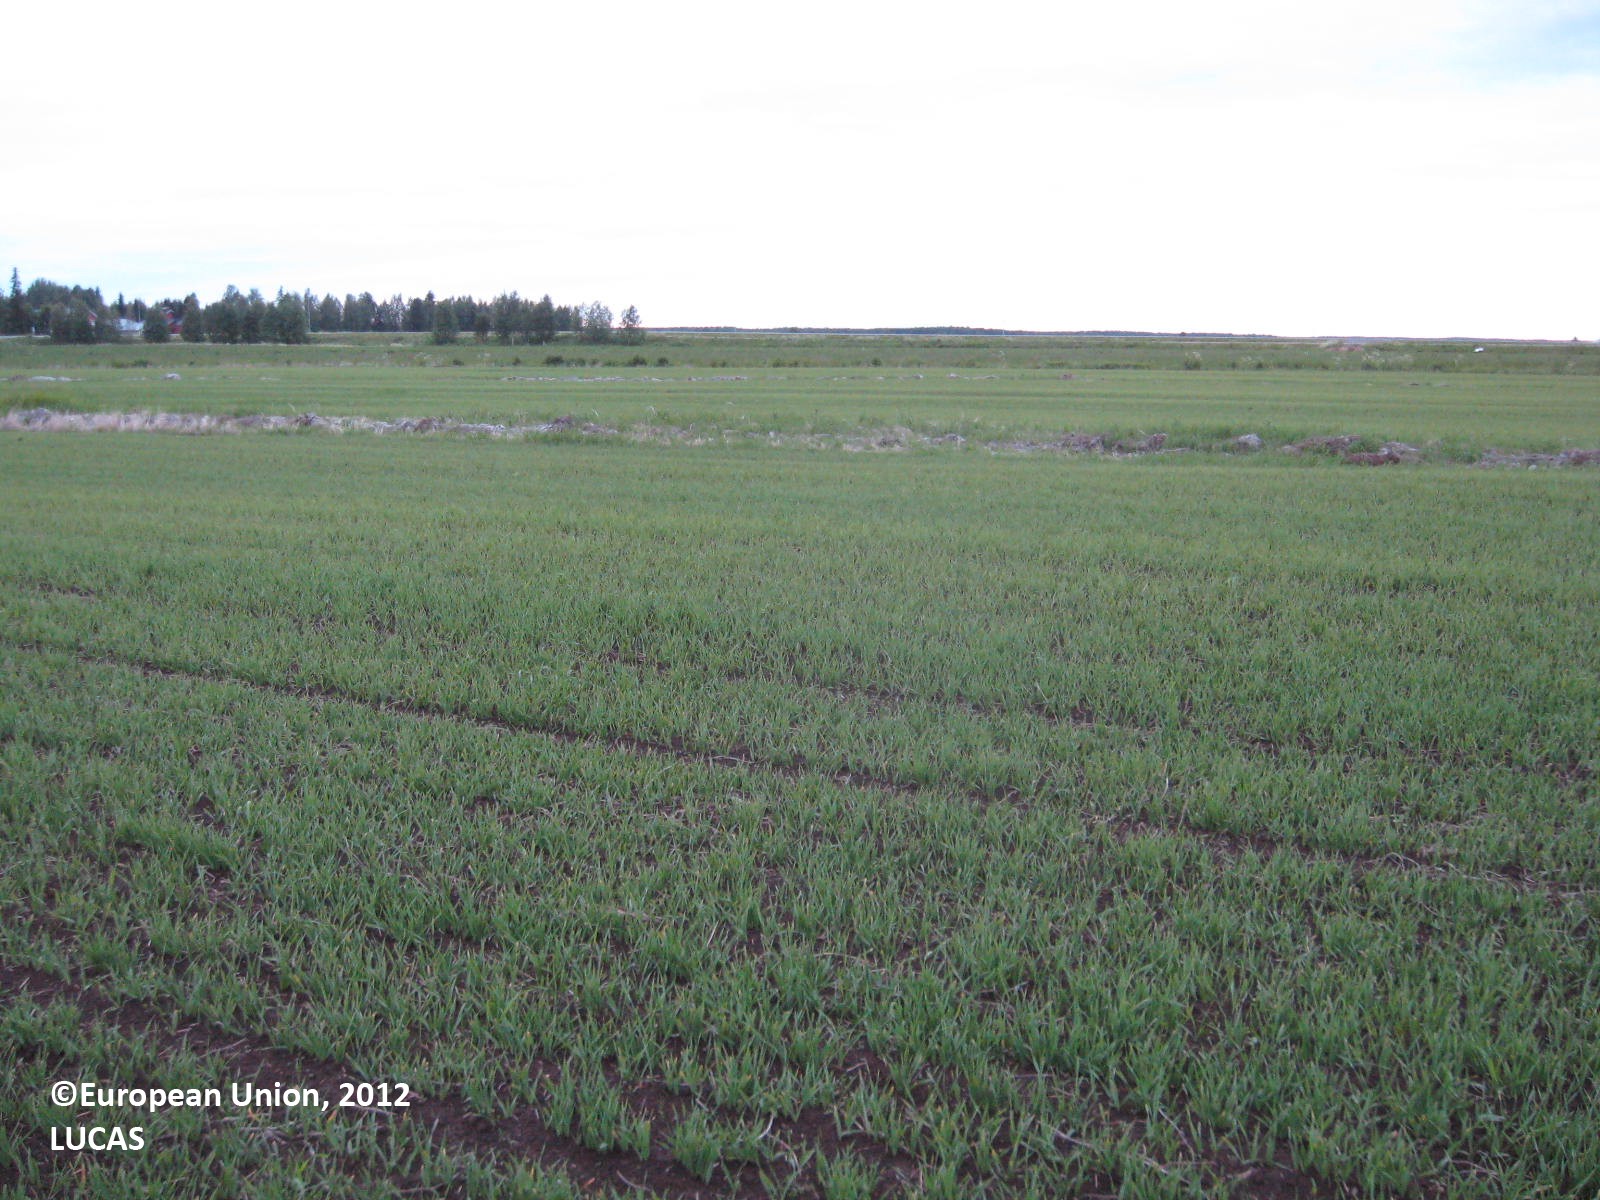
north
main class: Cropland
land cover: Barley
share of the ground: 50 - 75 %
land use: Agriculture (excluding fallow land and kitchen gardens)
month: June
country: FI
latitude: 62.8537
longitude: 22.7671
